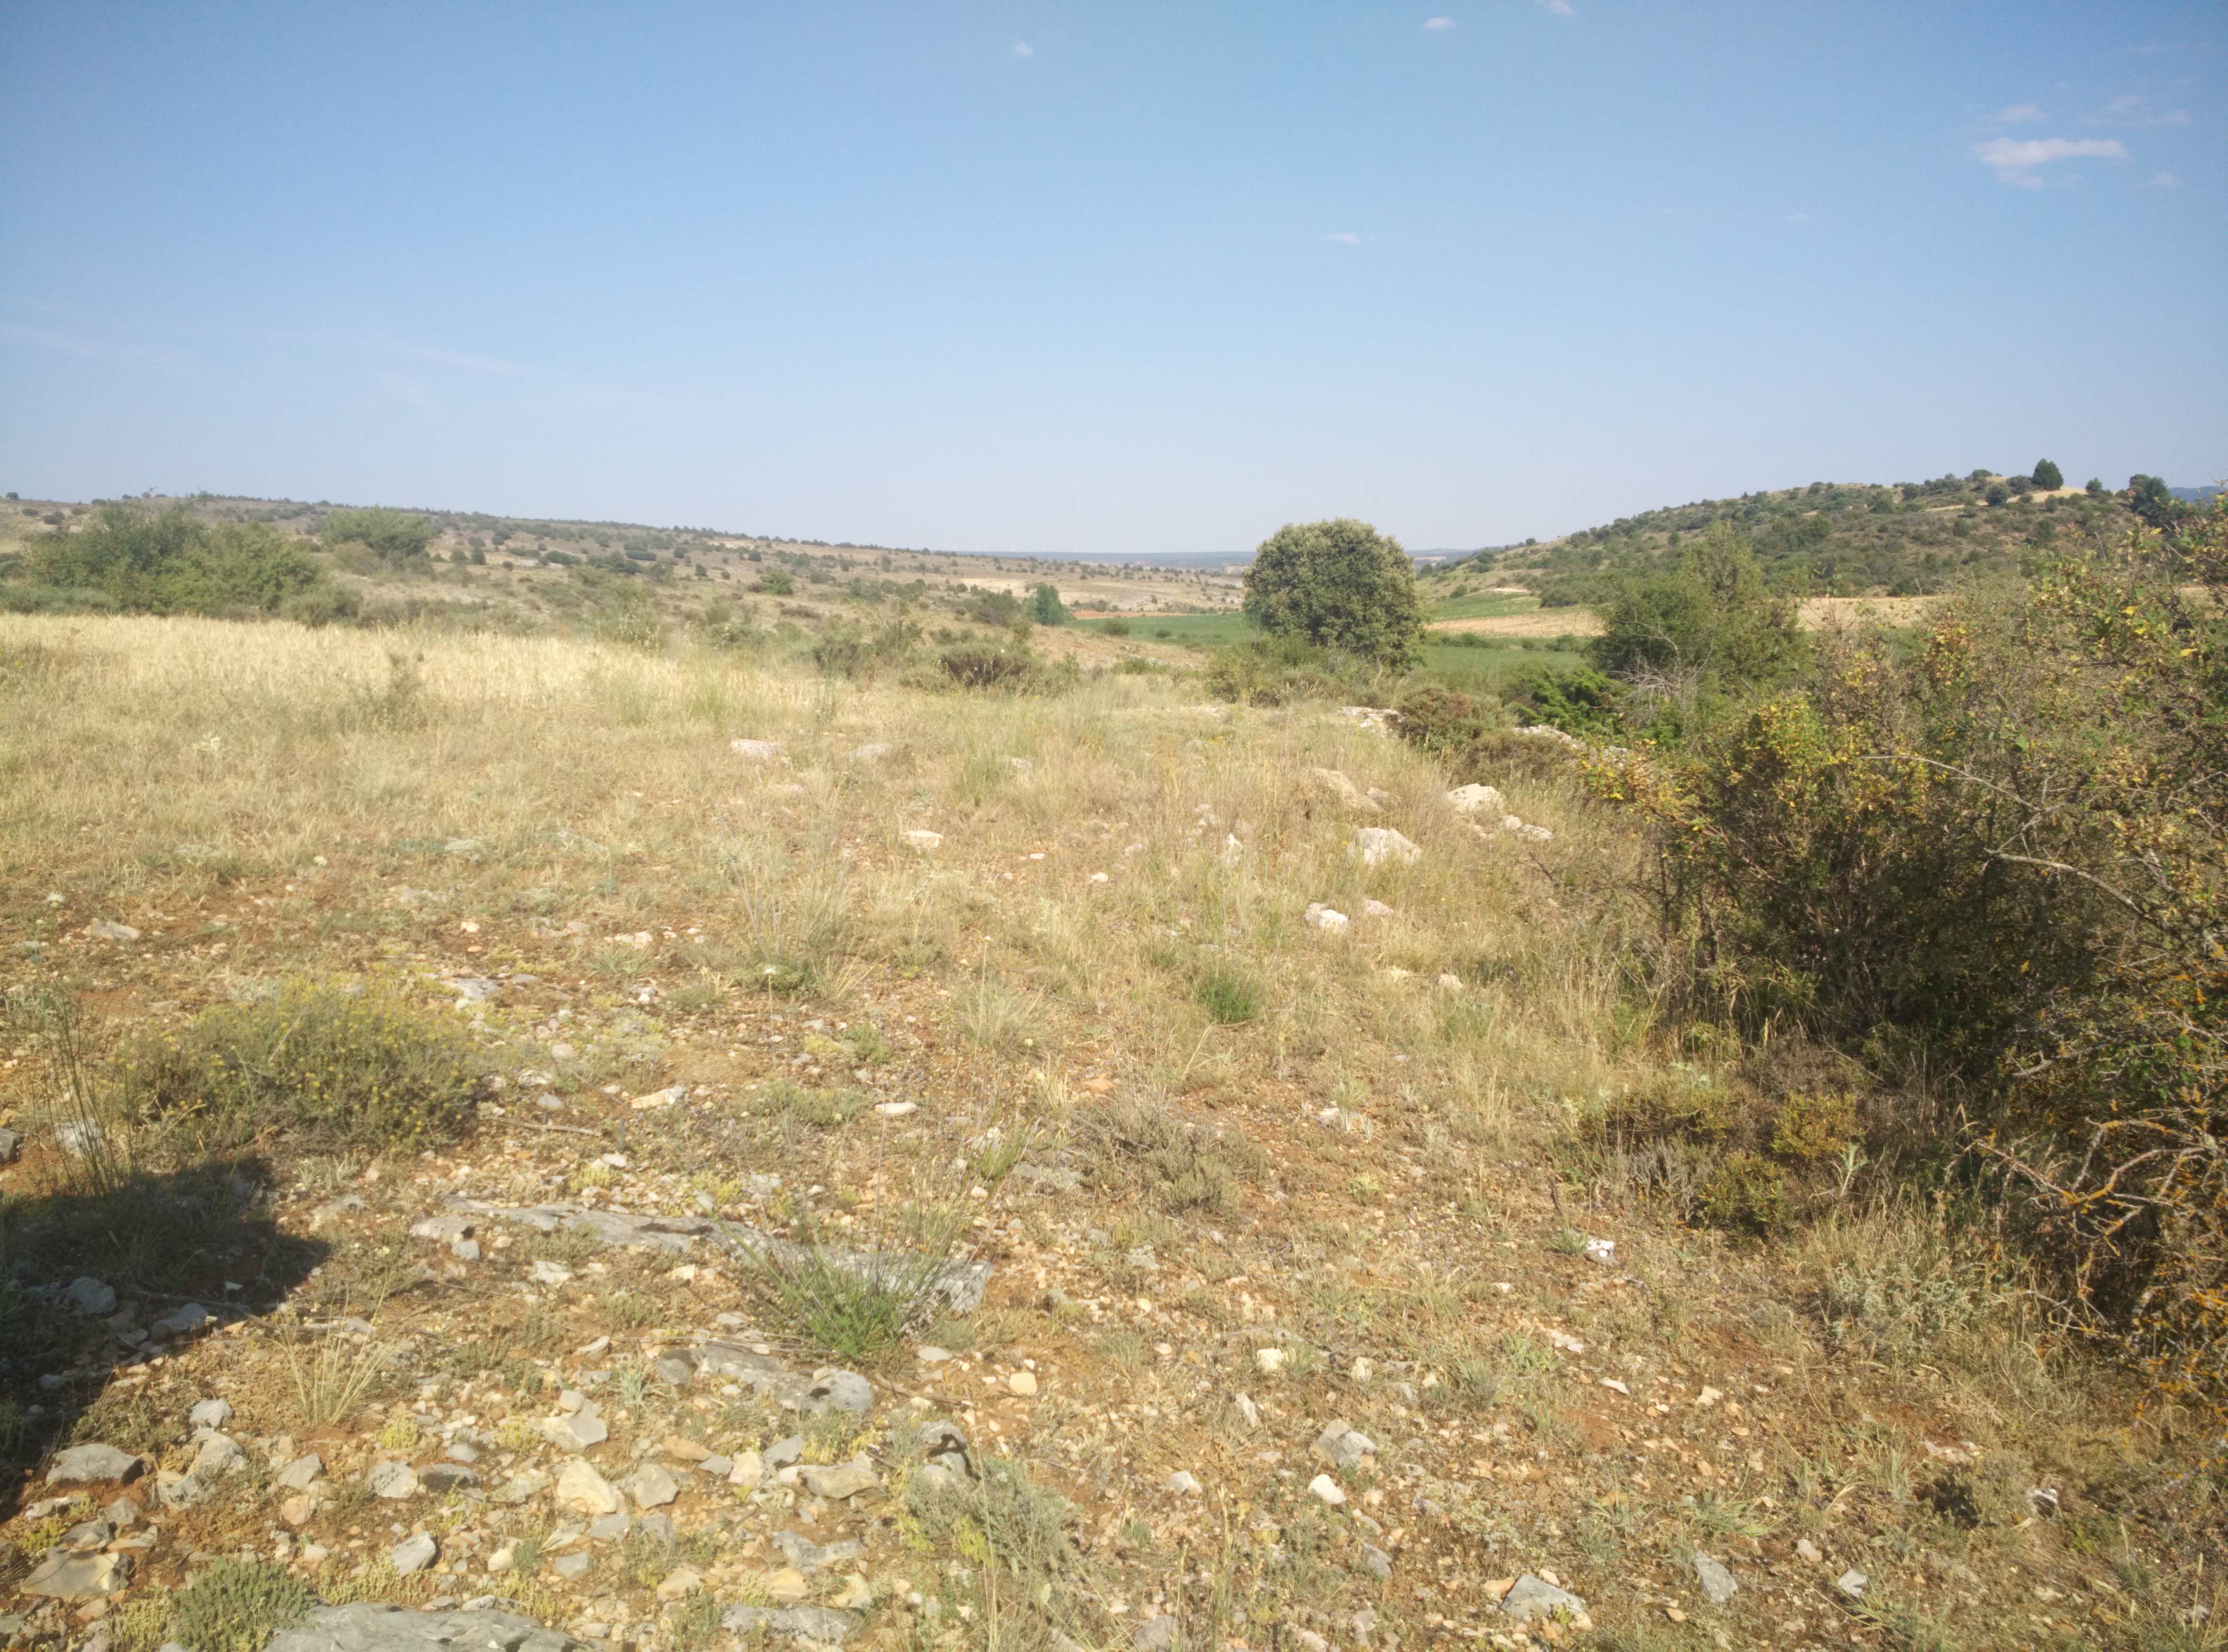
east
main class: Shrubland
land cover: Shrubland without tree cover
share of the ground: 10 - 25 %
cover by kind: unconsolidated bare surface 45 %, shrubs 20 %, herbaceous plants 10 %
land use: Semi-natural and natural areas not in use
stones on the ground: 10 - 25 %
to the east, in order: Shrubland without tree cover; Barley; Shrubland without tree cover; Rock outcrops; Shrubland without tree cover
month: July
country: ES
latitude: 41.0081
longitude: -2.1423
